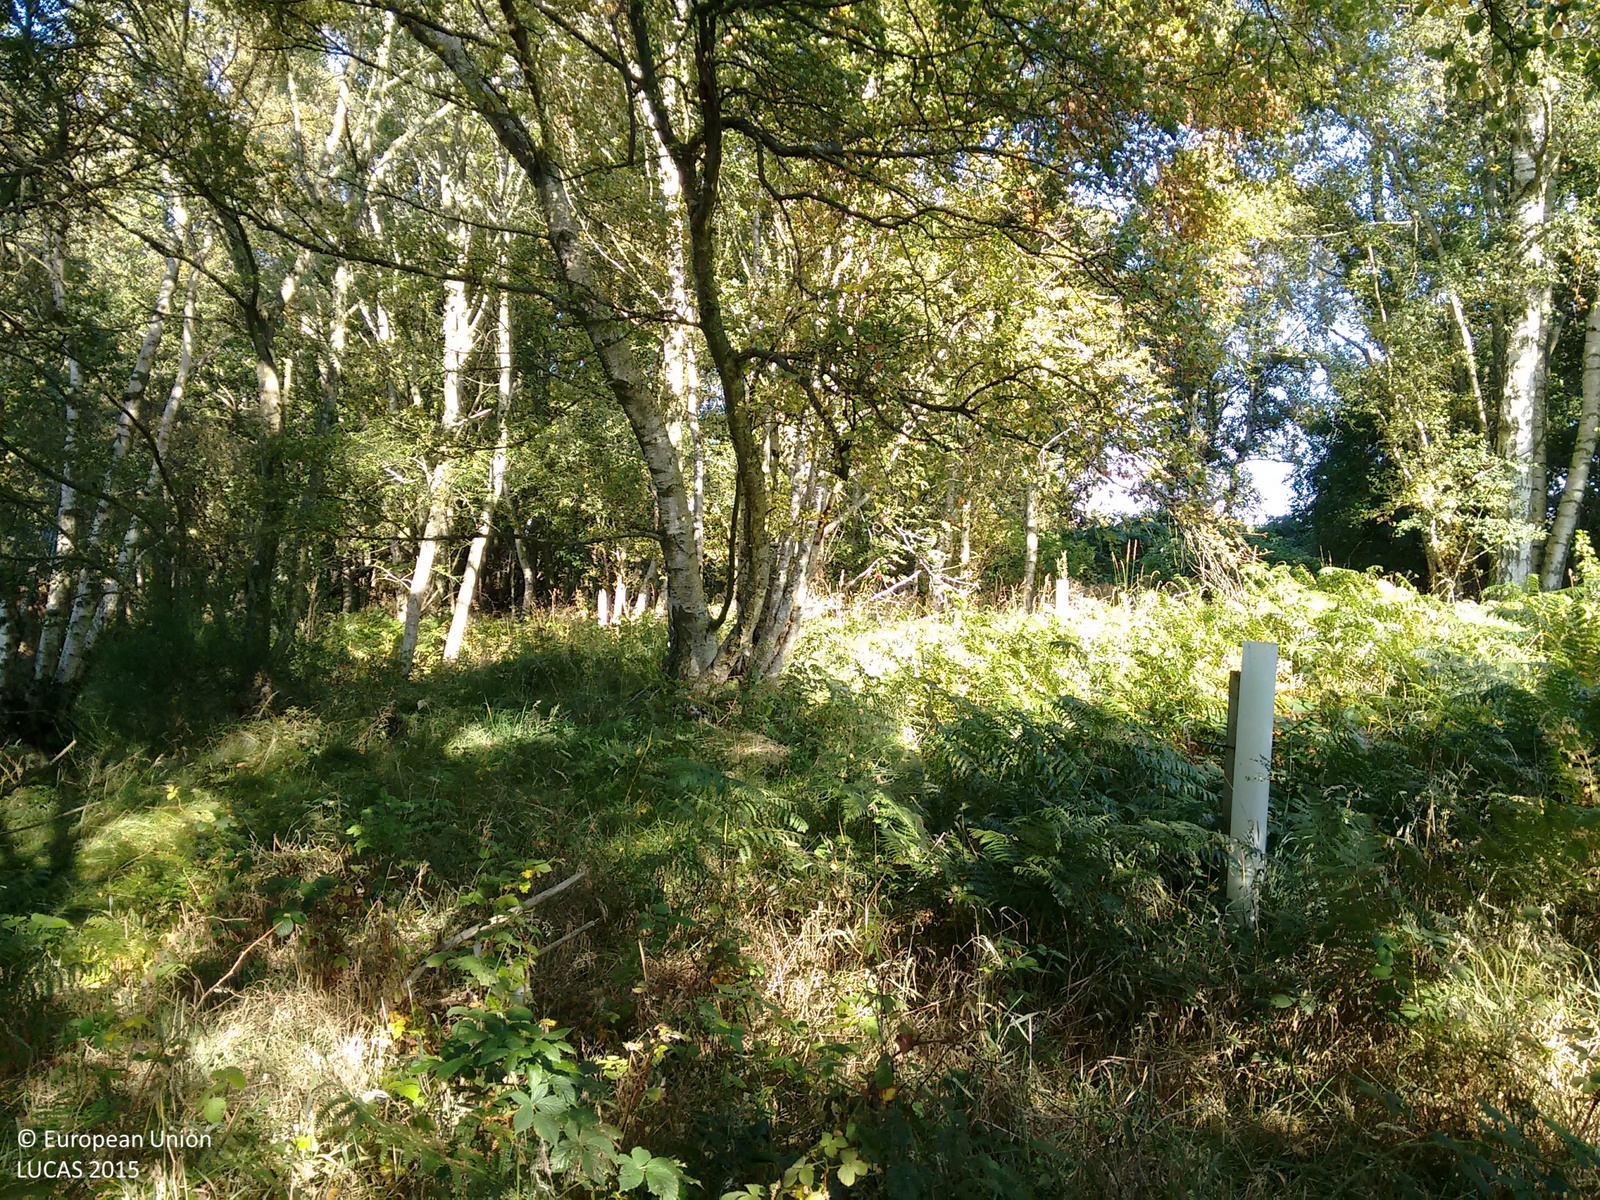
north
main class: Woodland
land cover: Broadleaved woodland
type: floodplain forest
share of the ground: > 75 %
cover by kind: broadleaved forest trees 70 %, herbaceous plants 30 %
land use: Amenities, museums, leisure
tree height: > 5 m
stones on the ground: < 10 %
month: September
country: GB
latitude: 56.5799
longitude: -3.5387
